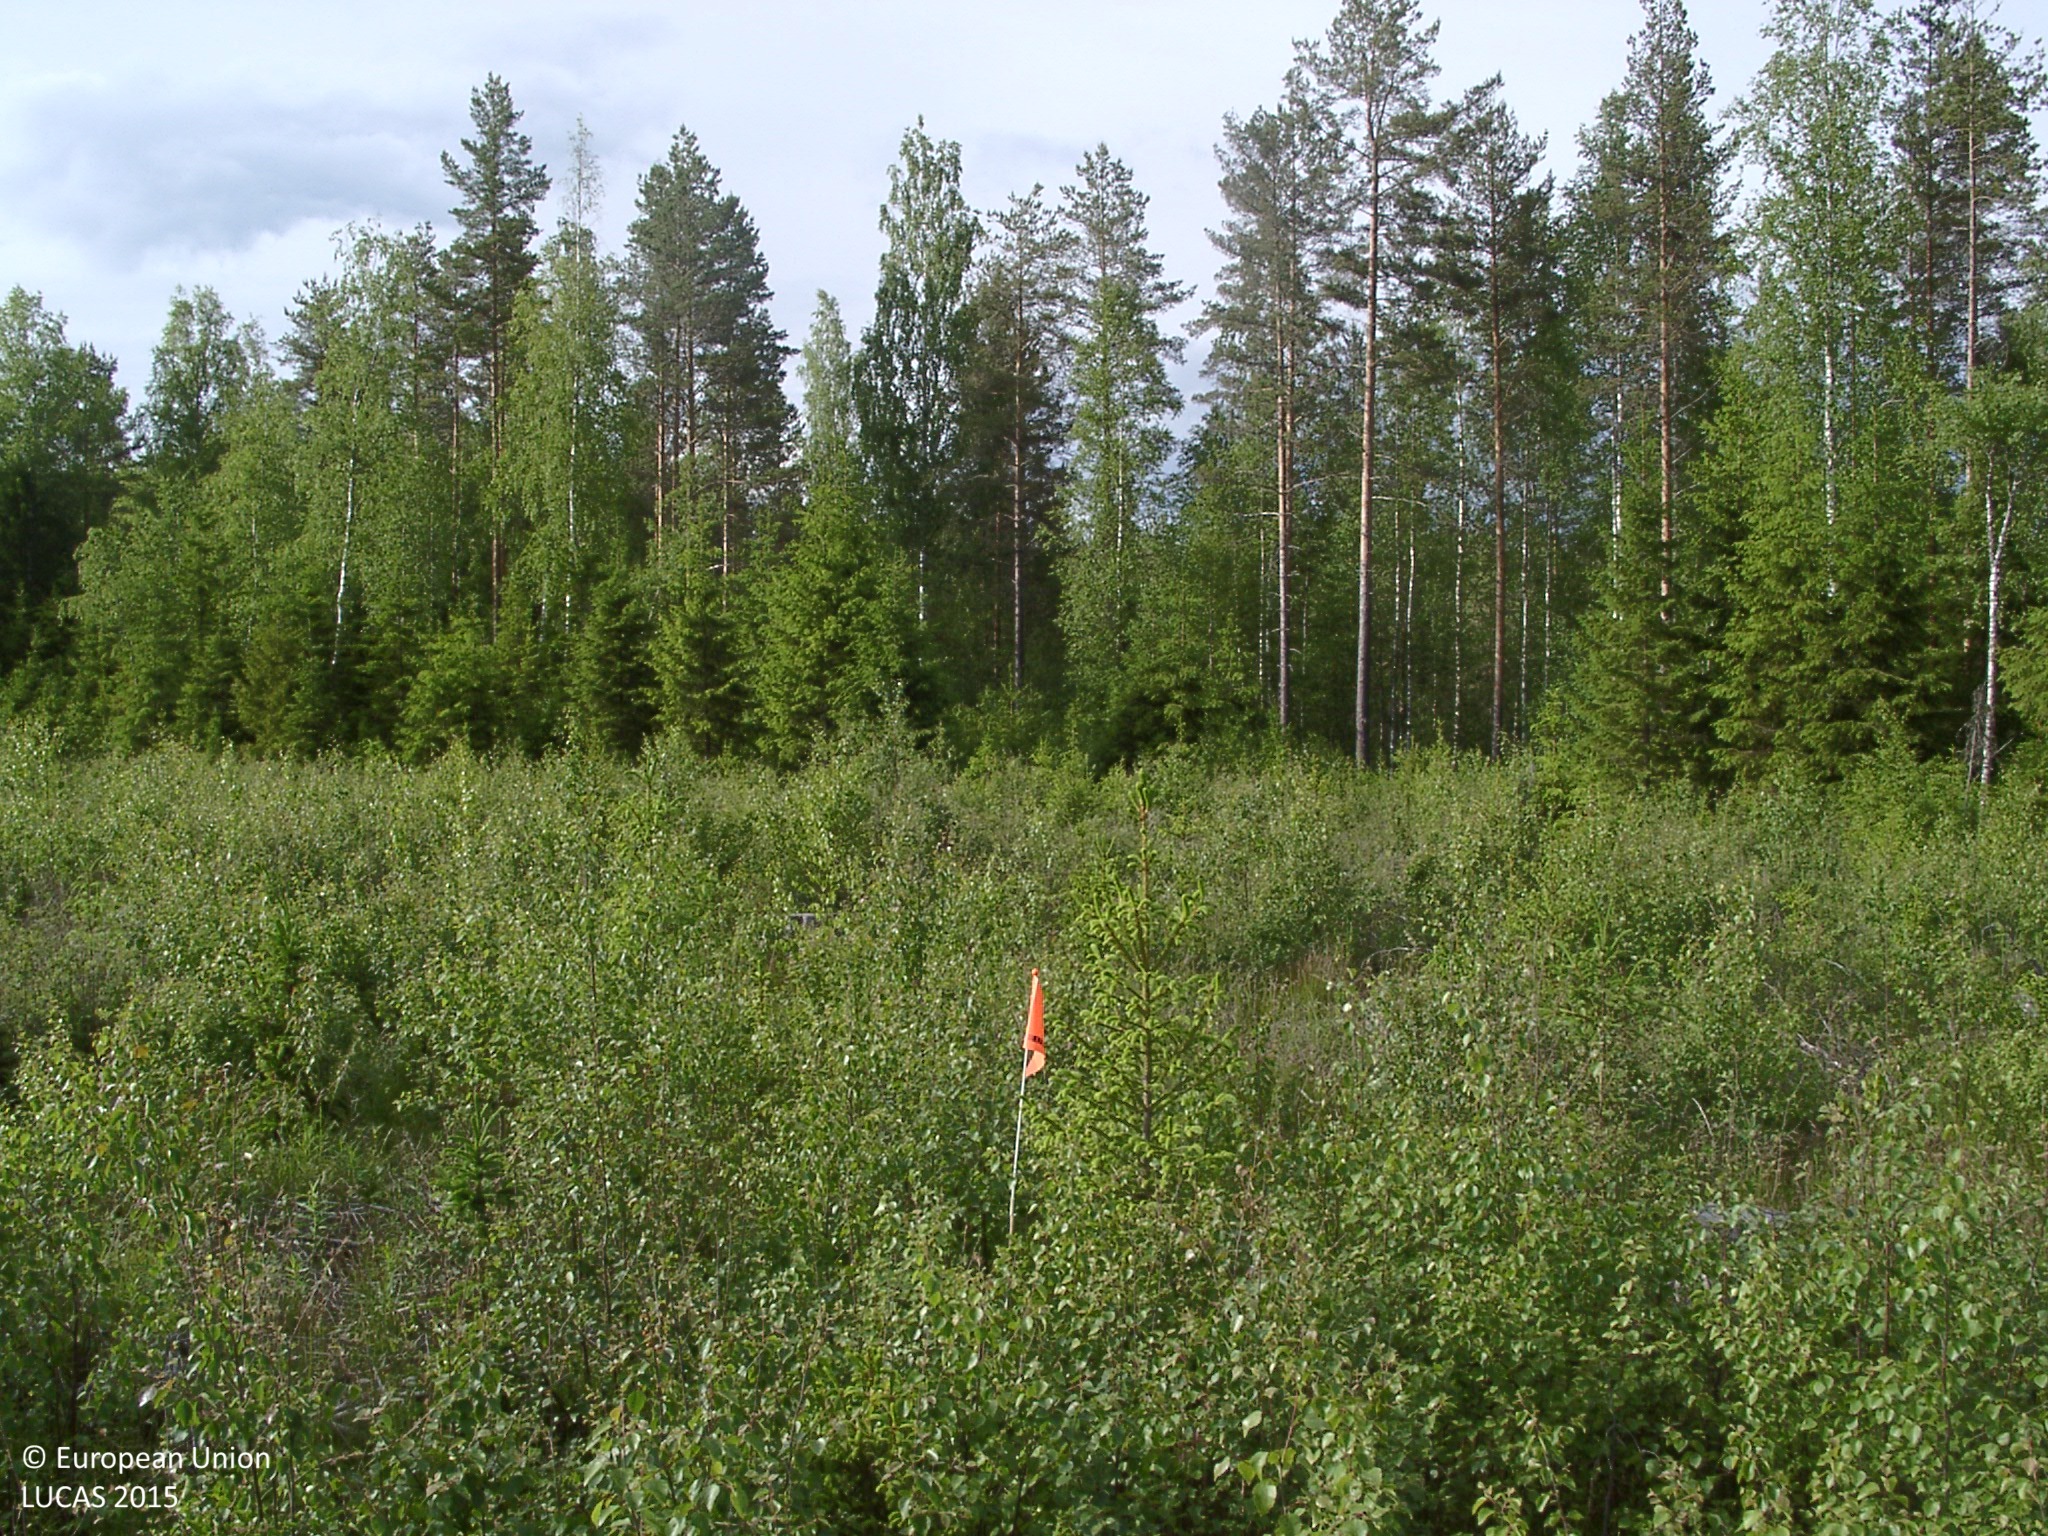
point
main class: Woodland
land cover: Broadleaved woodland
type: non-riverine alder, birch or aspen forest
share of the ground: 25 - 50 %
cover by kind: broadleaved forest trees 35 %, shrubs 25 %, herbaceous plants 25 %, coniferous forest trees 10 %, lichens and mosses 5 %
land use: Forestry
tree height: < 5 m
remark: Nursery
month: June
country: FI
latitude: 61.9314
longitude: 24.7892
